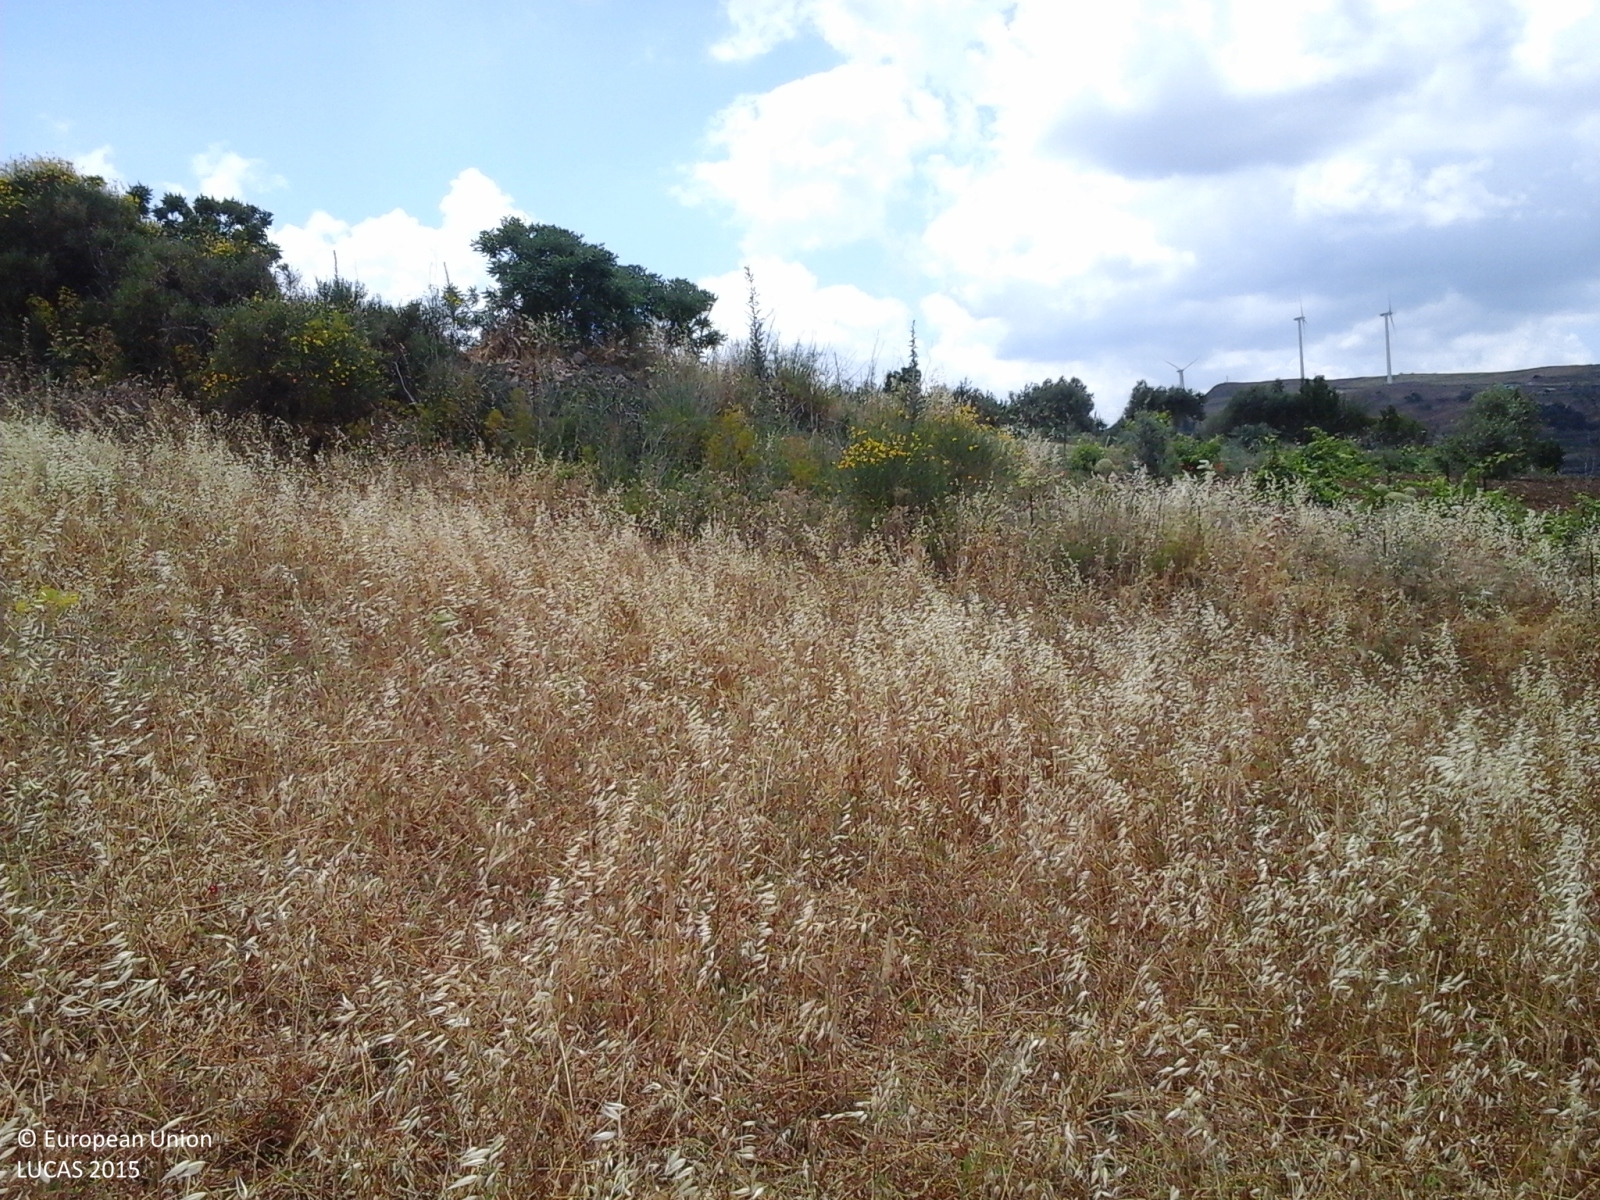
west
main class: Grassland
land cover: Spontaneously vegetated surfaces
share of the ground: > 75 %
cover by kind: herbaceous plants 100 %
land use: Fallow land
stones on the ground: < 10 %
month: June
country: IT
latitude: 37.9007
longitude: 13.5117
